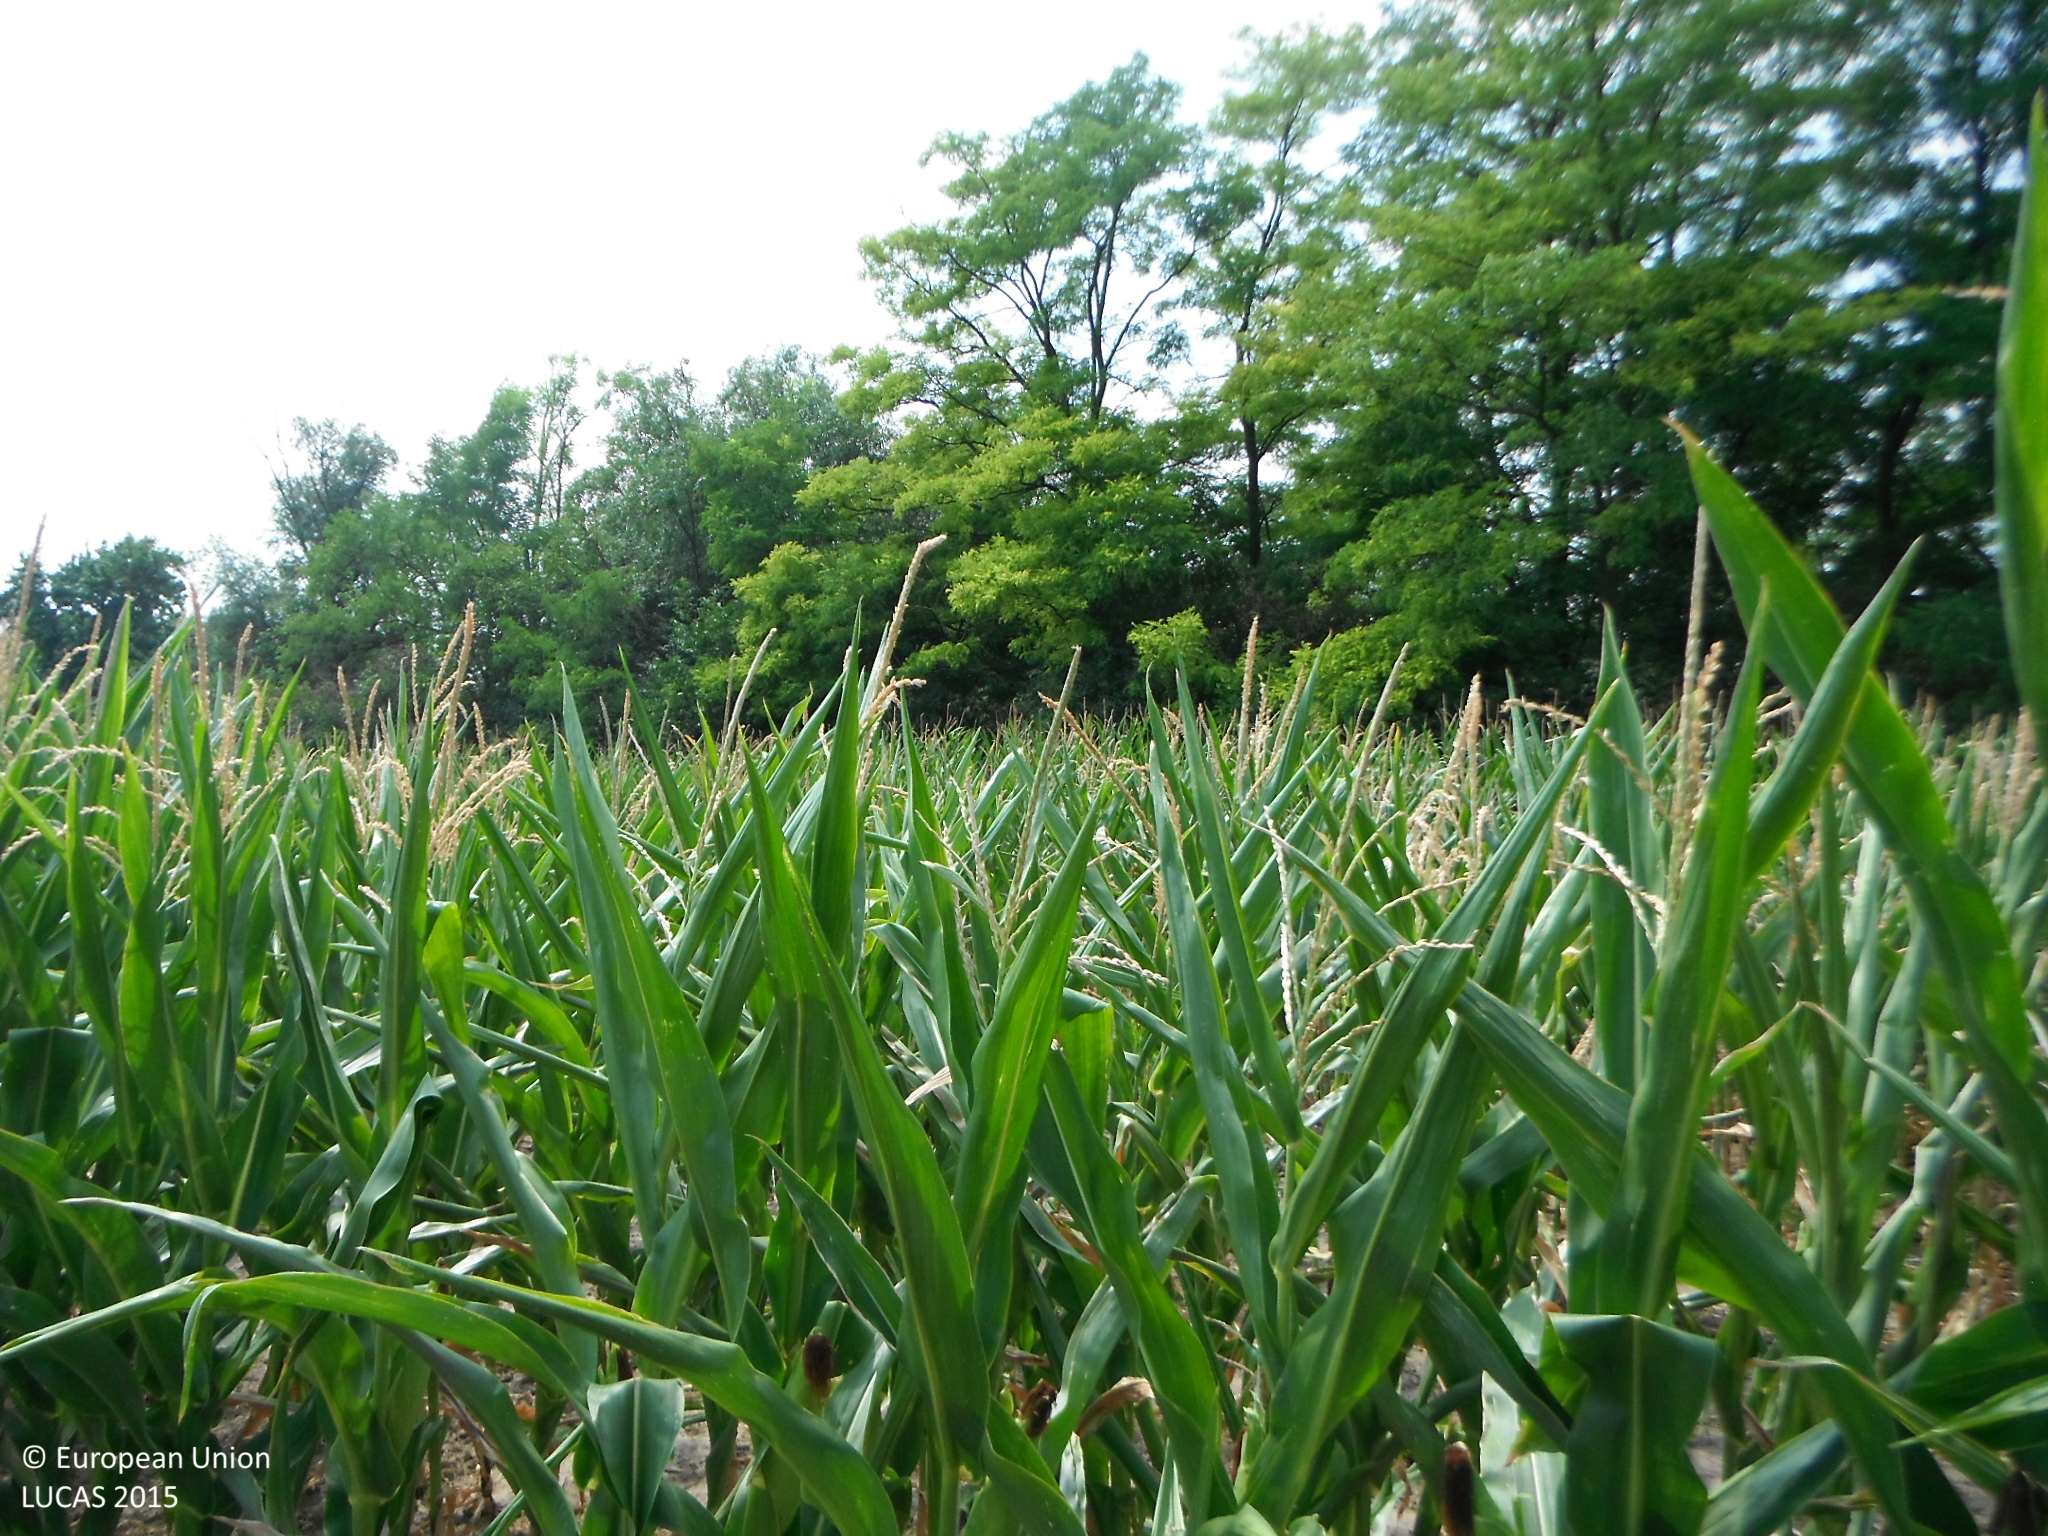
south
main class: Cropland
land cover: Maize
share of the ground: > 75 %
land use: Agriculture (excluding fallow land and kitchen gardens)
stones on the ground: < 10 %
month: August
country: SK
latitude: 48.2024
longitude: 18.0188
